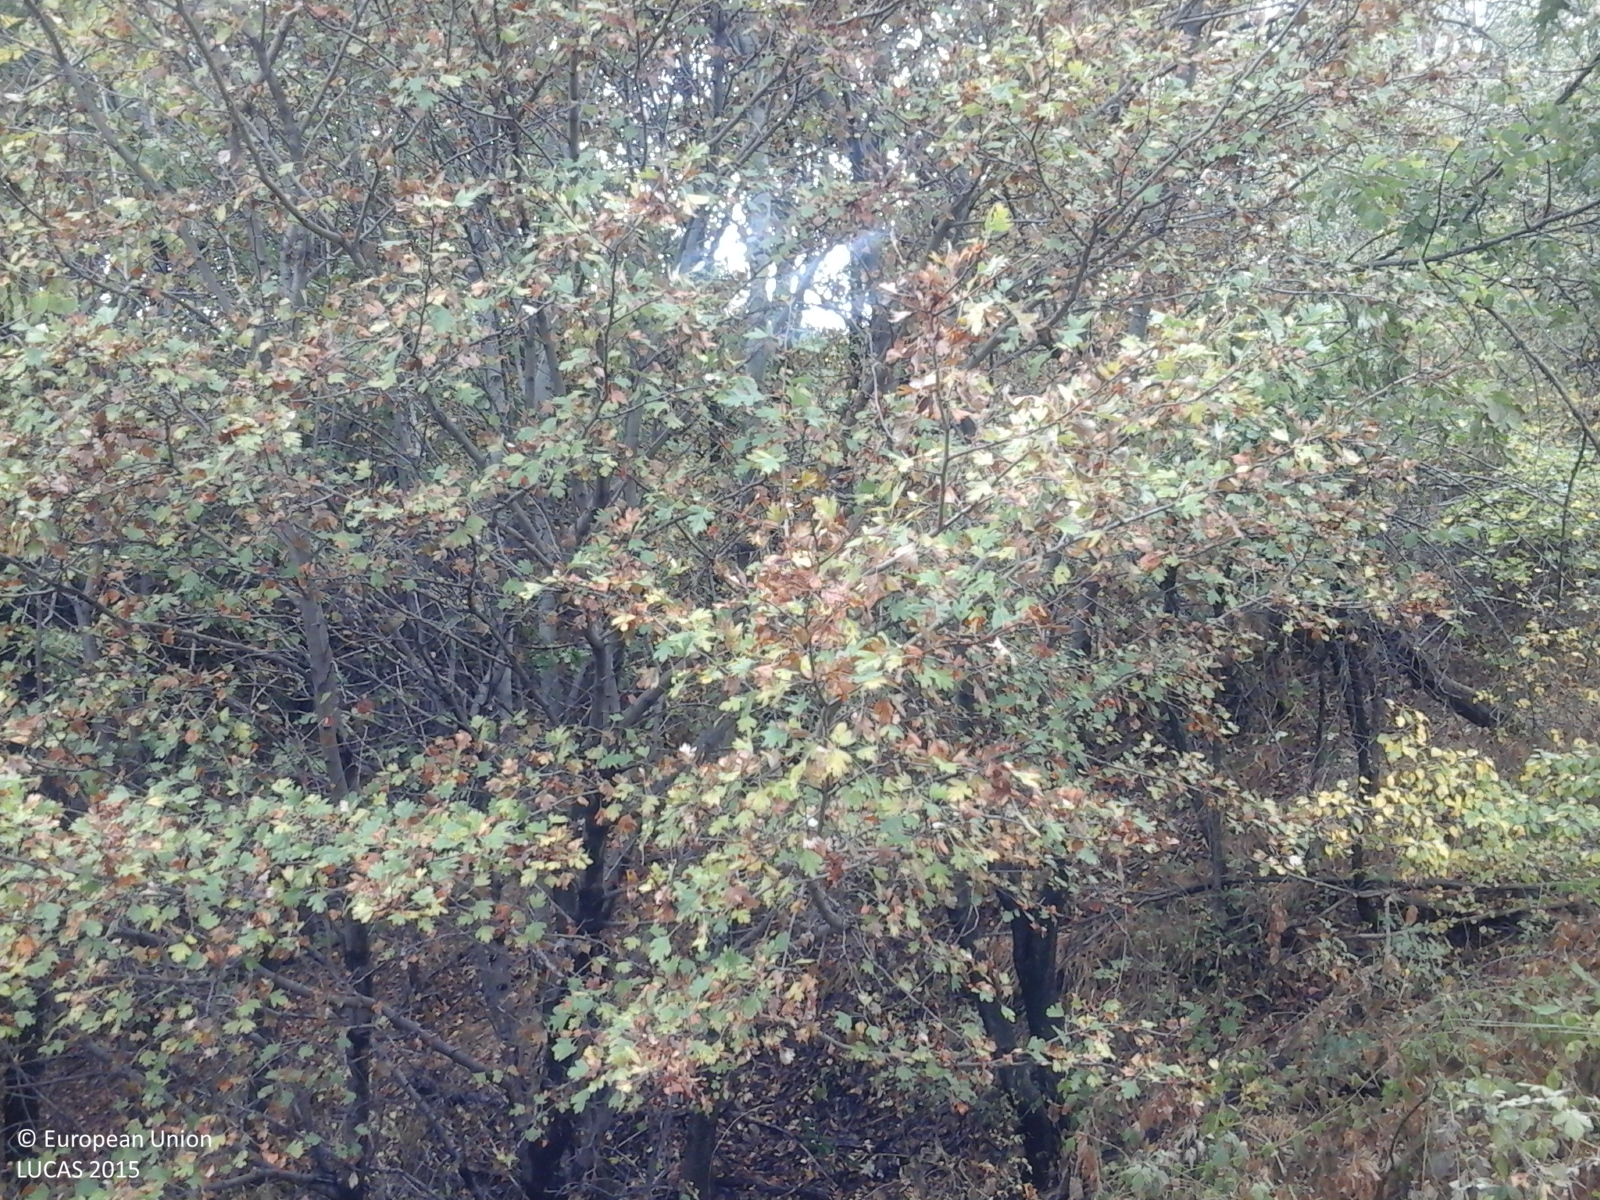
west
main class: Woodland
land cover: Broadleaved woodland
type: acidophilous oak and oak-birch forest
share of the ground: > 75 %
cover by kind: broadleaved forest trees 100 %
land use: Forestry
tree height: > 5 m
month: August
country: RO
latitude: 44.7481
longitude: 22.5836
